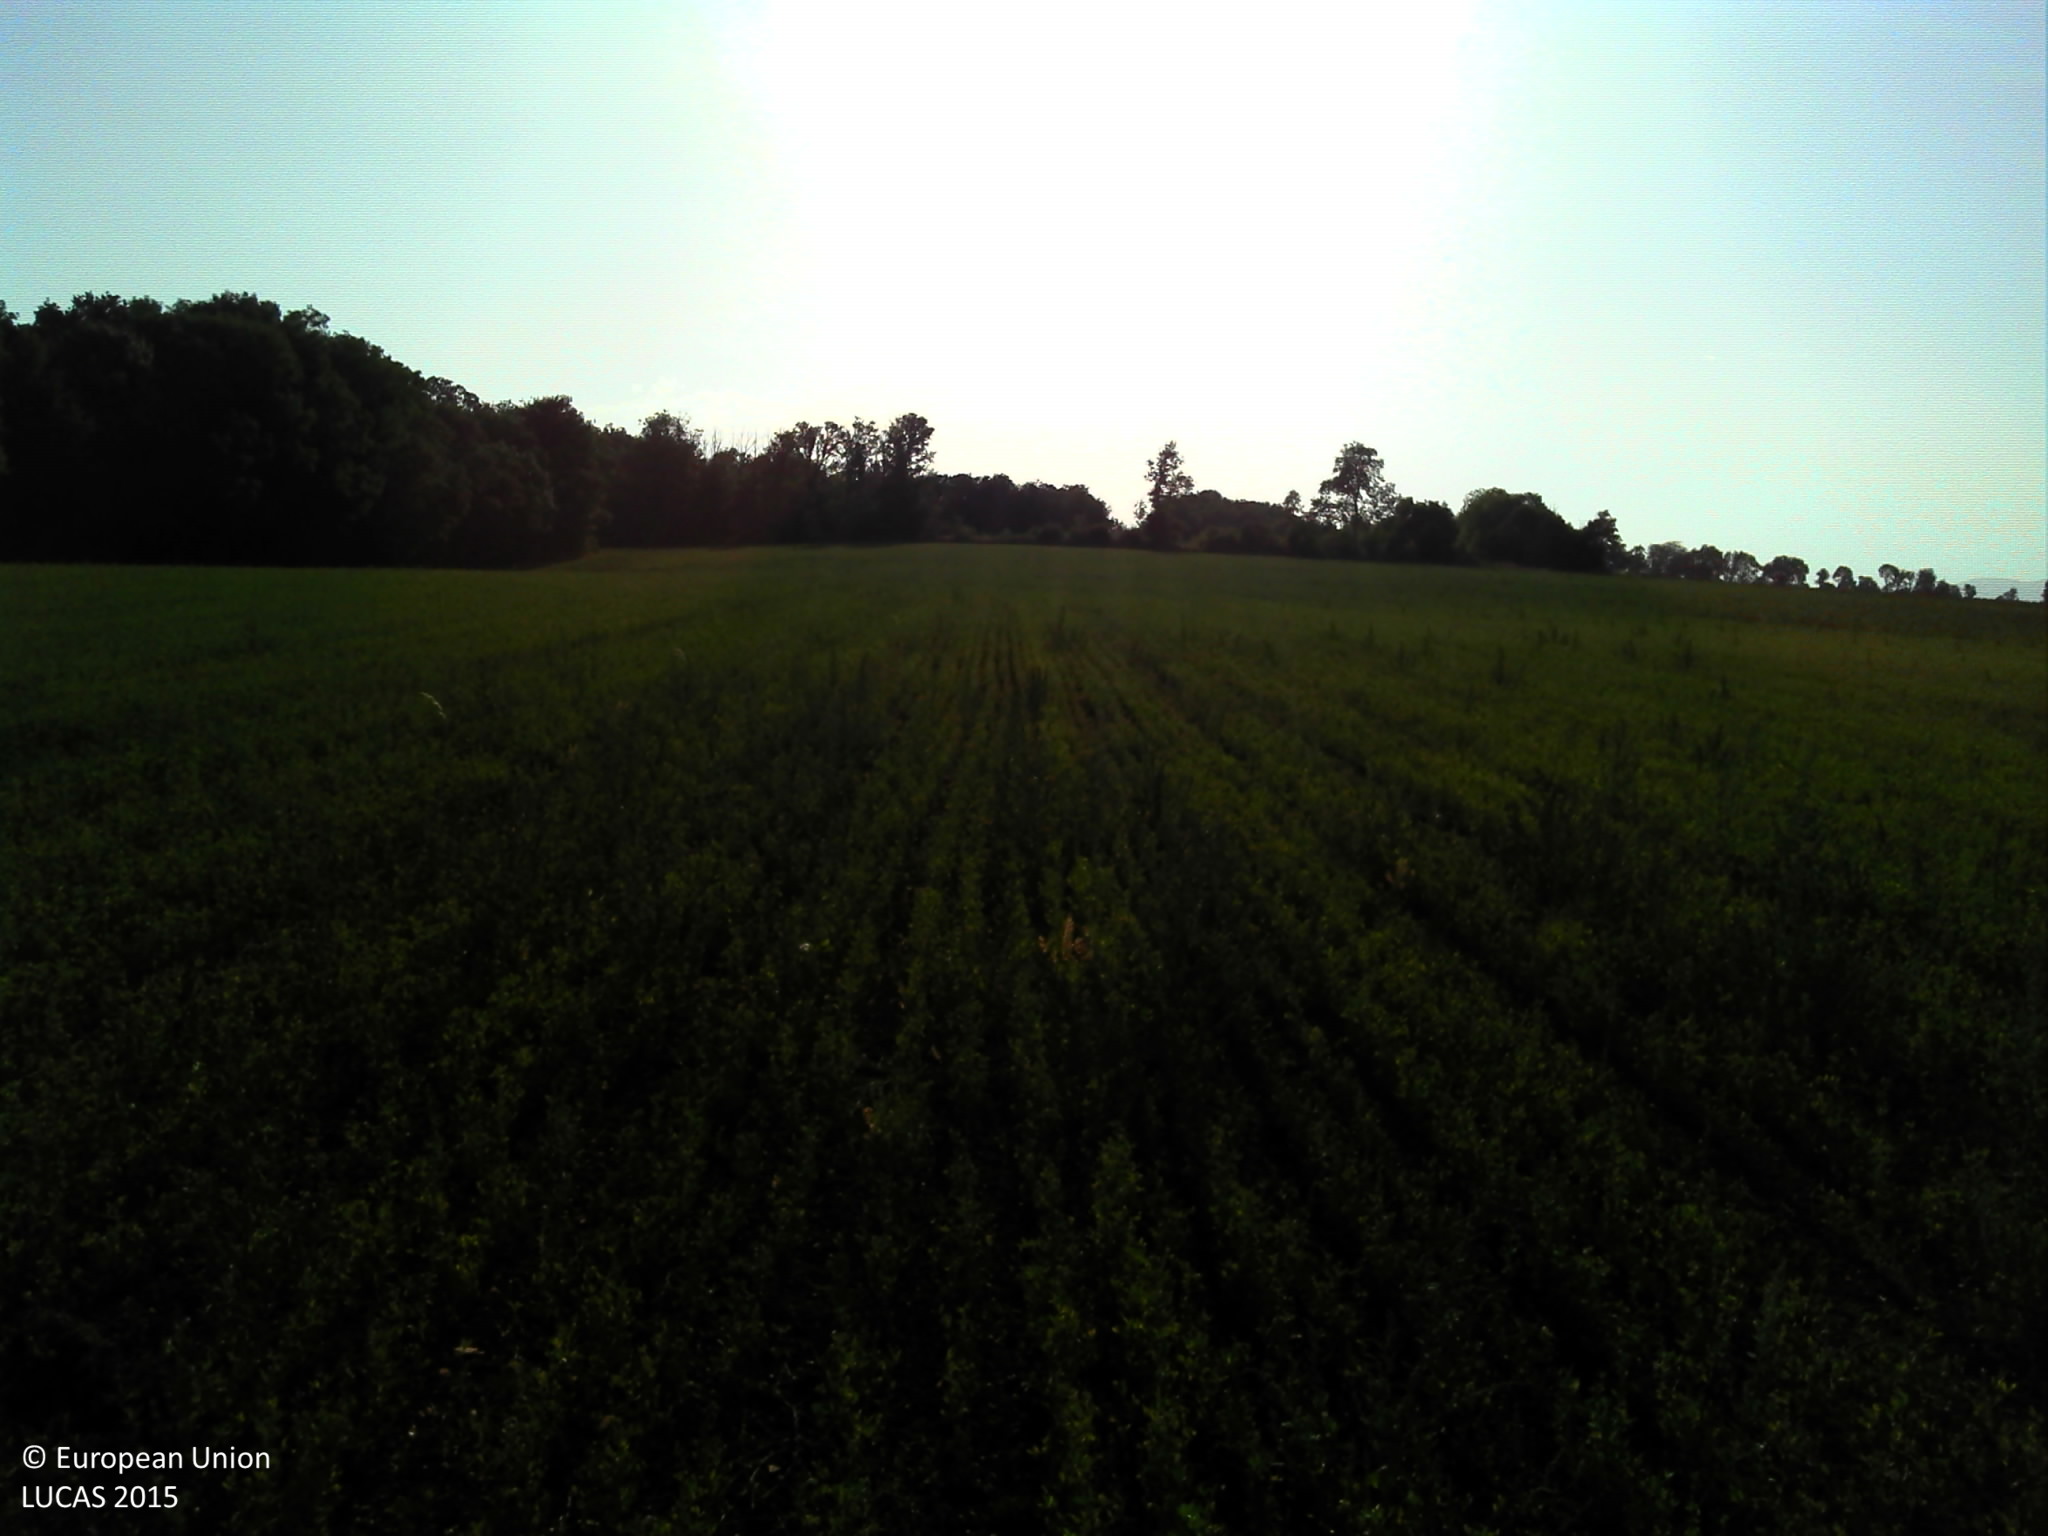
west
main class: Cropland
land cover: Lucerne
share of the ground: 50 - 75 %
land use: Agriculture (excluding fallow land and kitchen gardens)
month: August
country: FR
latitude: 44.0127
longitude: 3.1084
